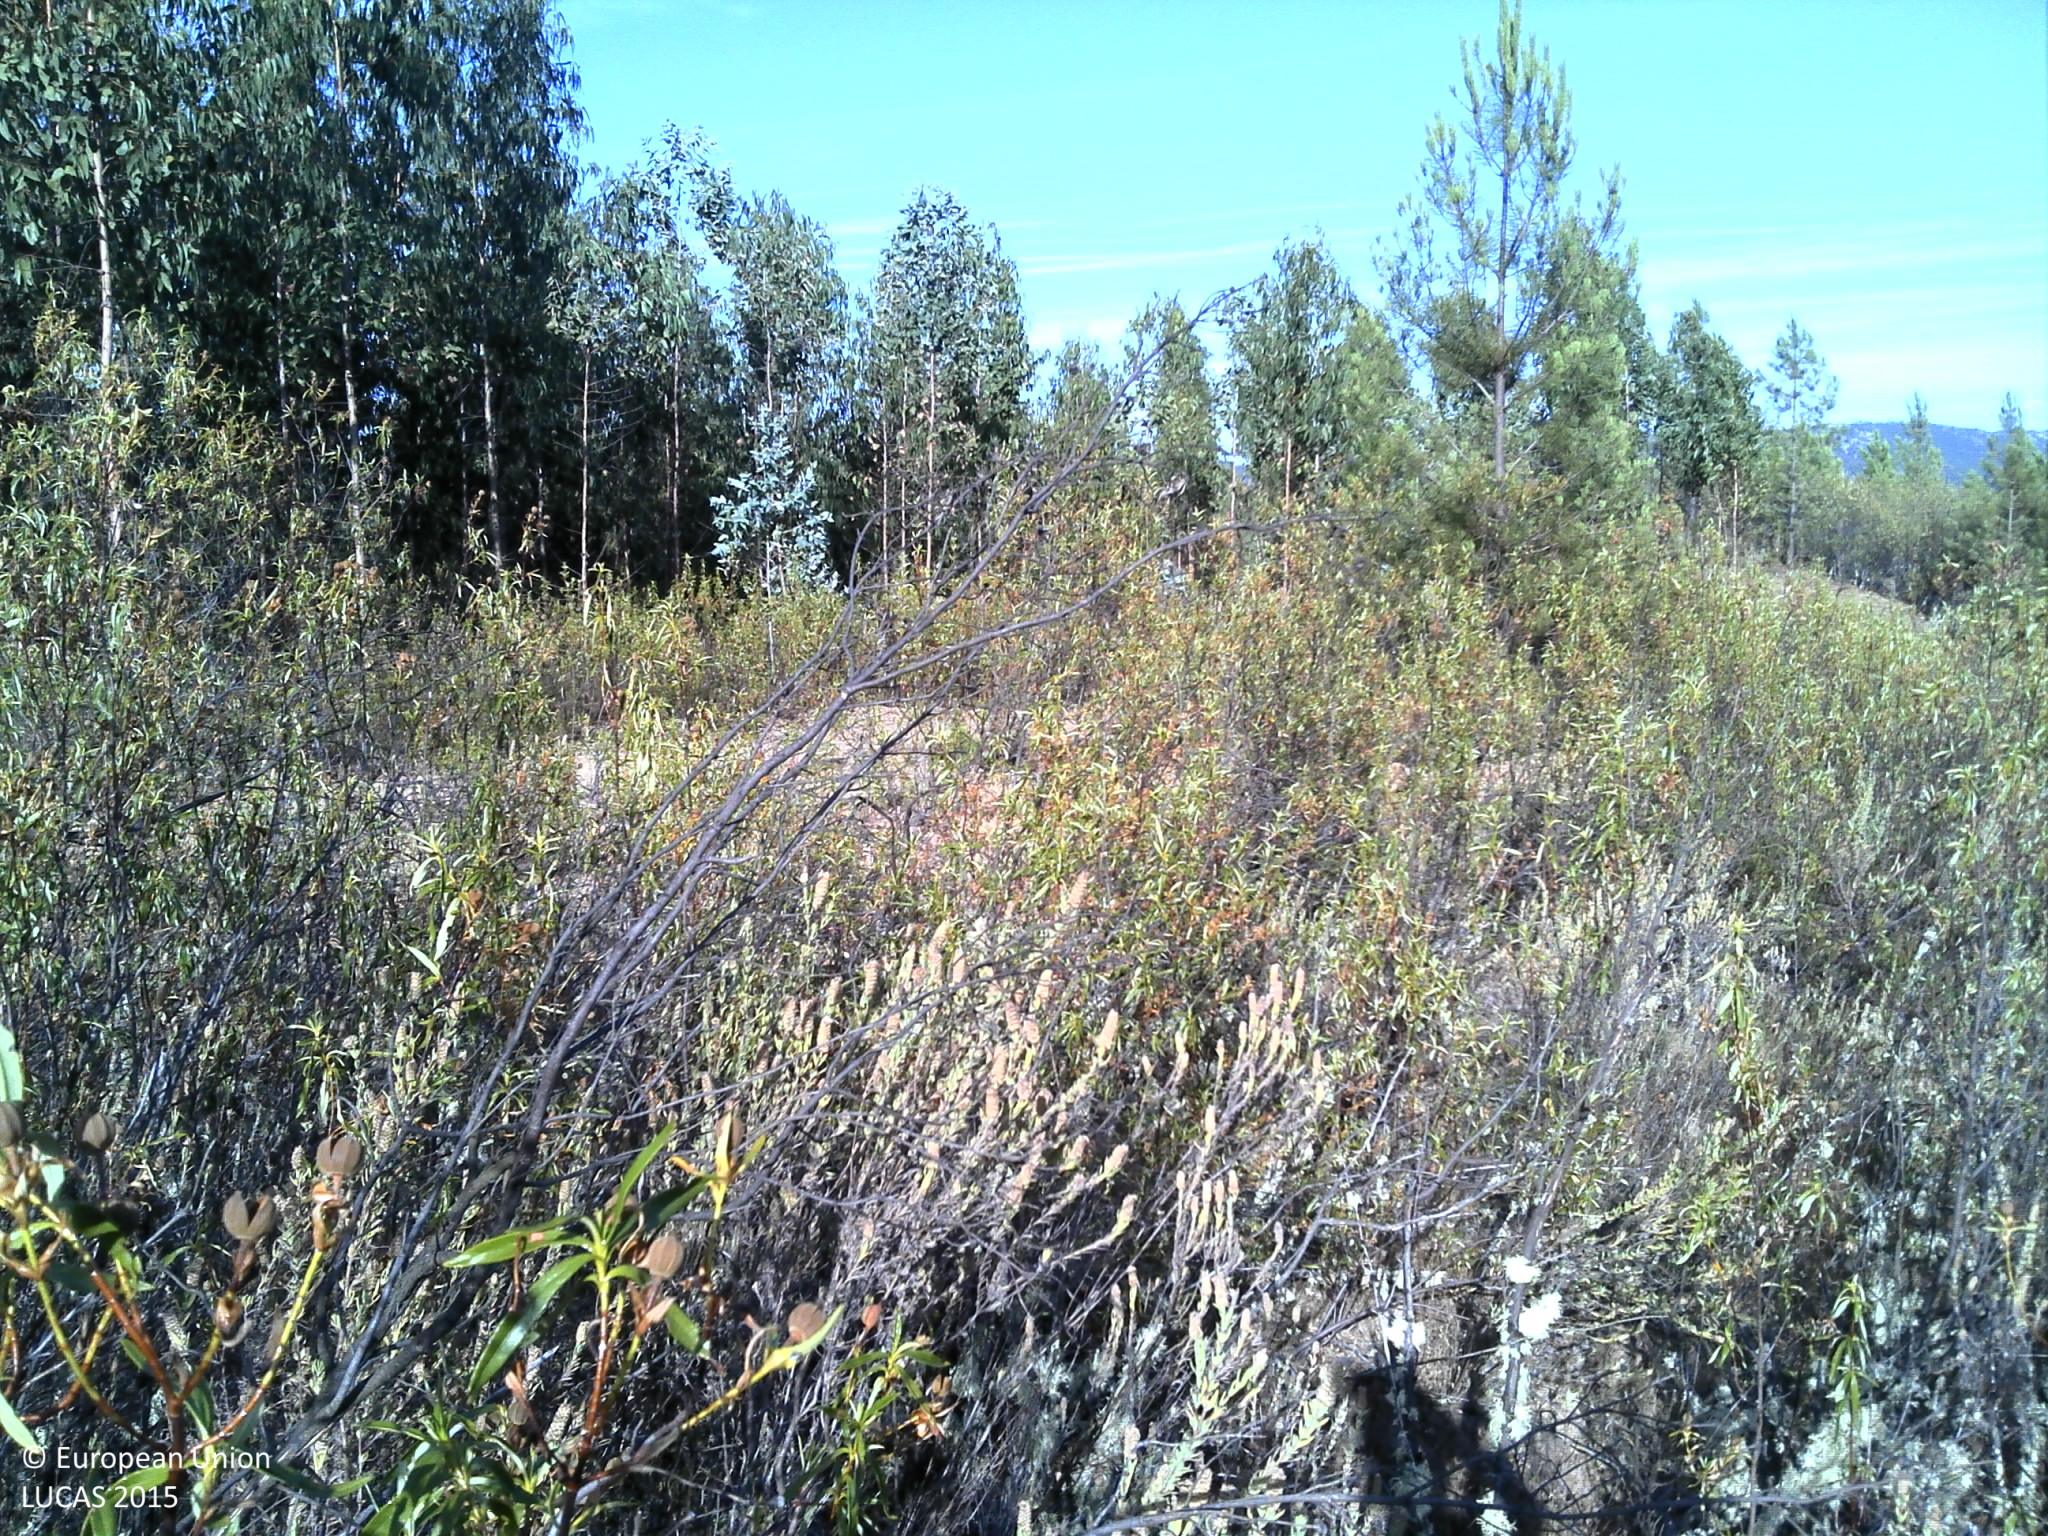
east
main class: Woodland
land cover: Pine dominated coniferous woodland
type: coniferous forest of the mediterranean region
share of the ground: < 10 %
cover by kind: shrubs 90 %, coniferous forest trees 10 %
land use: Forestry
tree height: < 5 m
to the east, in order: Pine dominated coniferous woodland; Tracks; Broadleaved woodland; Pine dominated coniferous woodland; Broadleaved woodland; Shrubland with sparse tree cover; Shrubland without tree cover; Rivers and streams
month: July
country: PT
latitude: 39.7322
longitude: -7.8052
